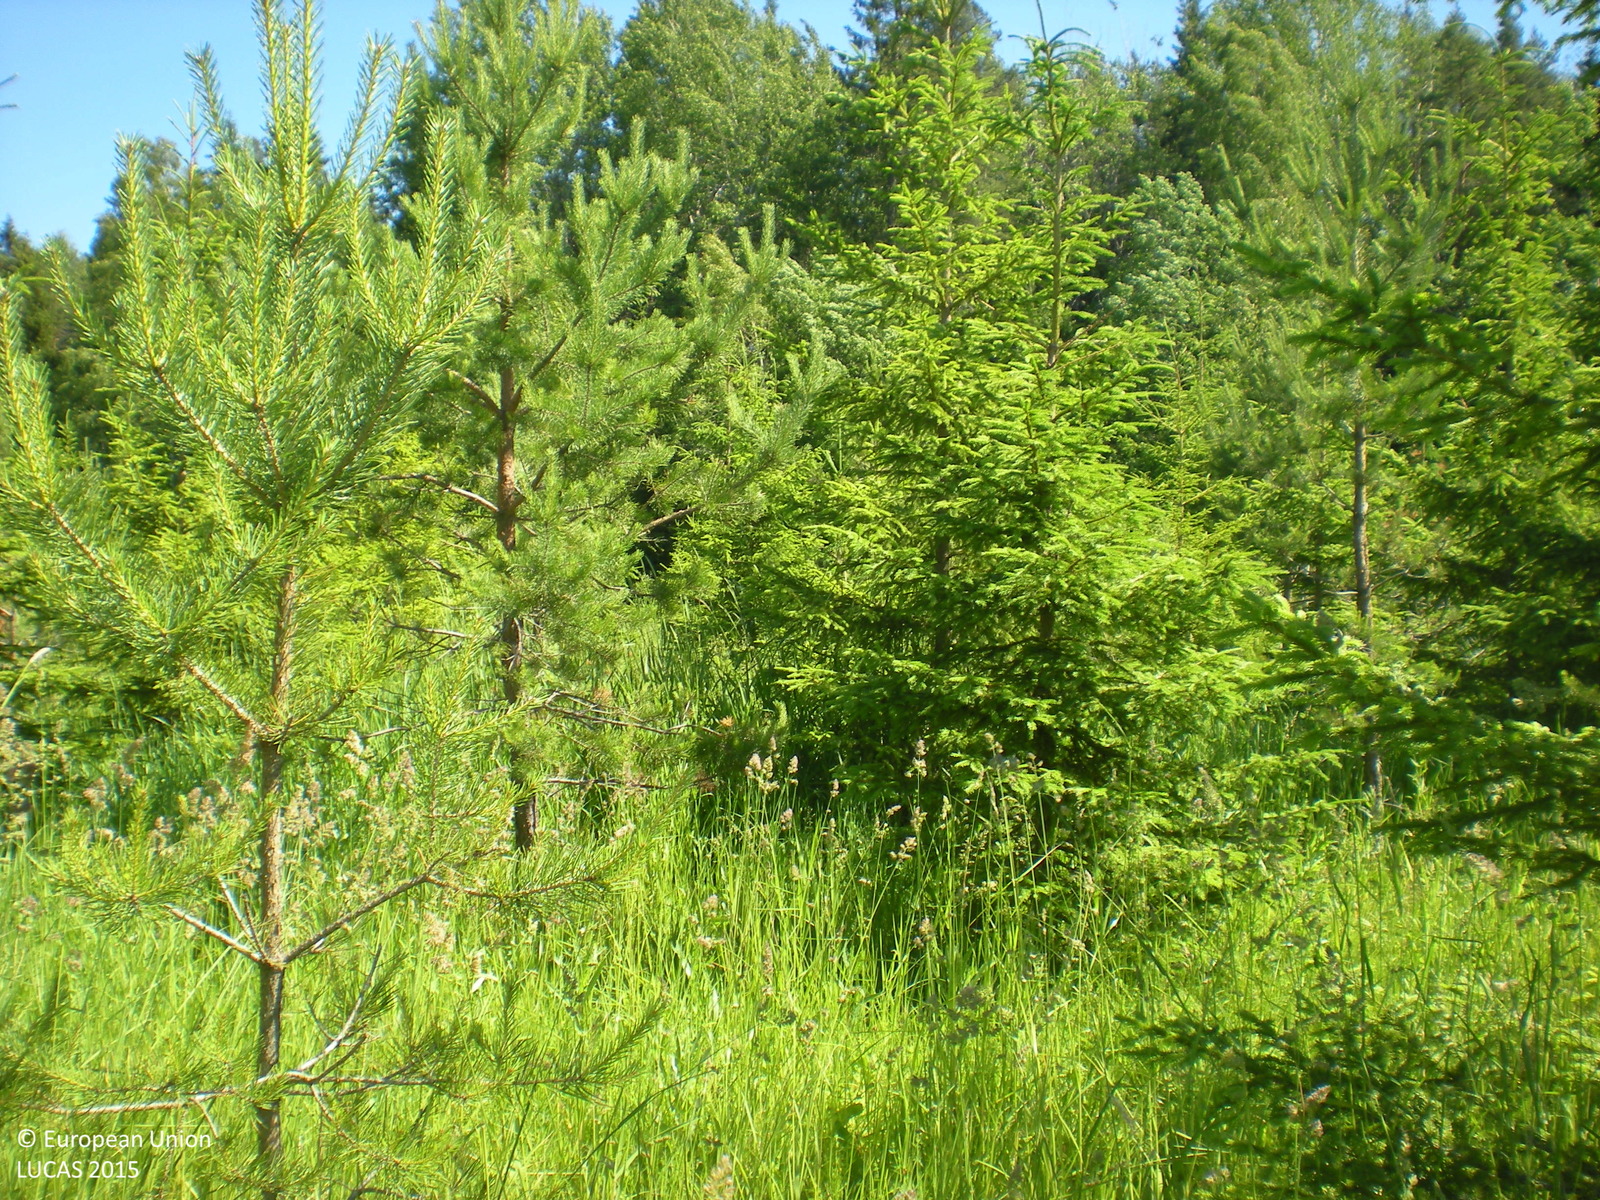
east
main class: Woodland
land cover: Other coniferous woodland
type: boreal forest
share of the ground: 10 - 25 %
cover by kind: herbaceous plants 65 %, coniferous forest trees 35 %
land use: Forestry
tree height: < 5 m
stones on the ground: < 10 %
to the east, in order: Other coniferous woodland; Ditches and canals; Broadleaved woodland; Other coniferous woodland; Spruce dominated mixed woodland; Ditches and canals; Spruce dominated coniferous woodland; Other coniferous woodland
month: July
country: SE
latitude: 60.4916
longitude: 17.7636
